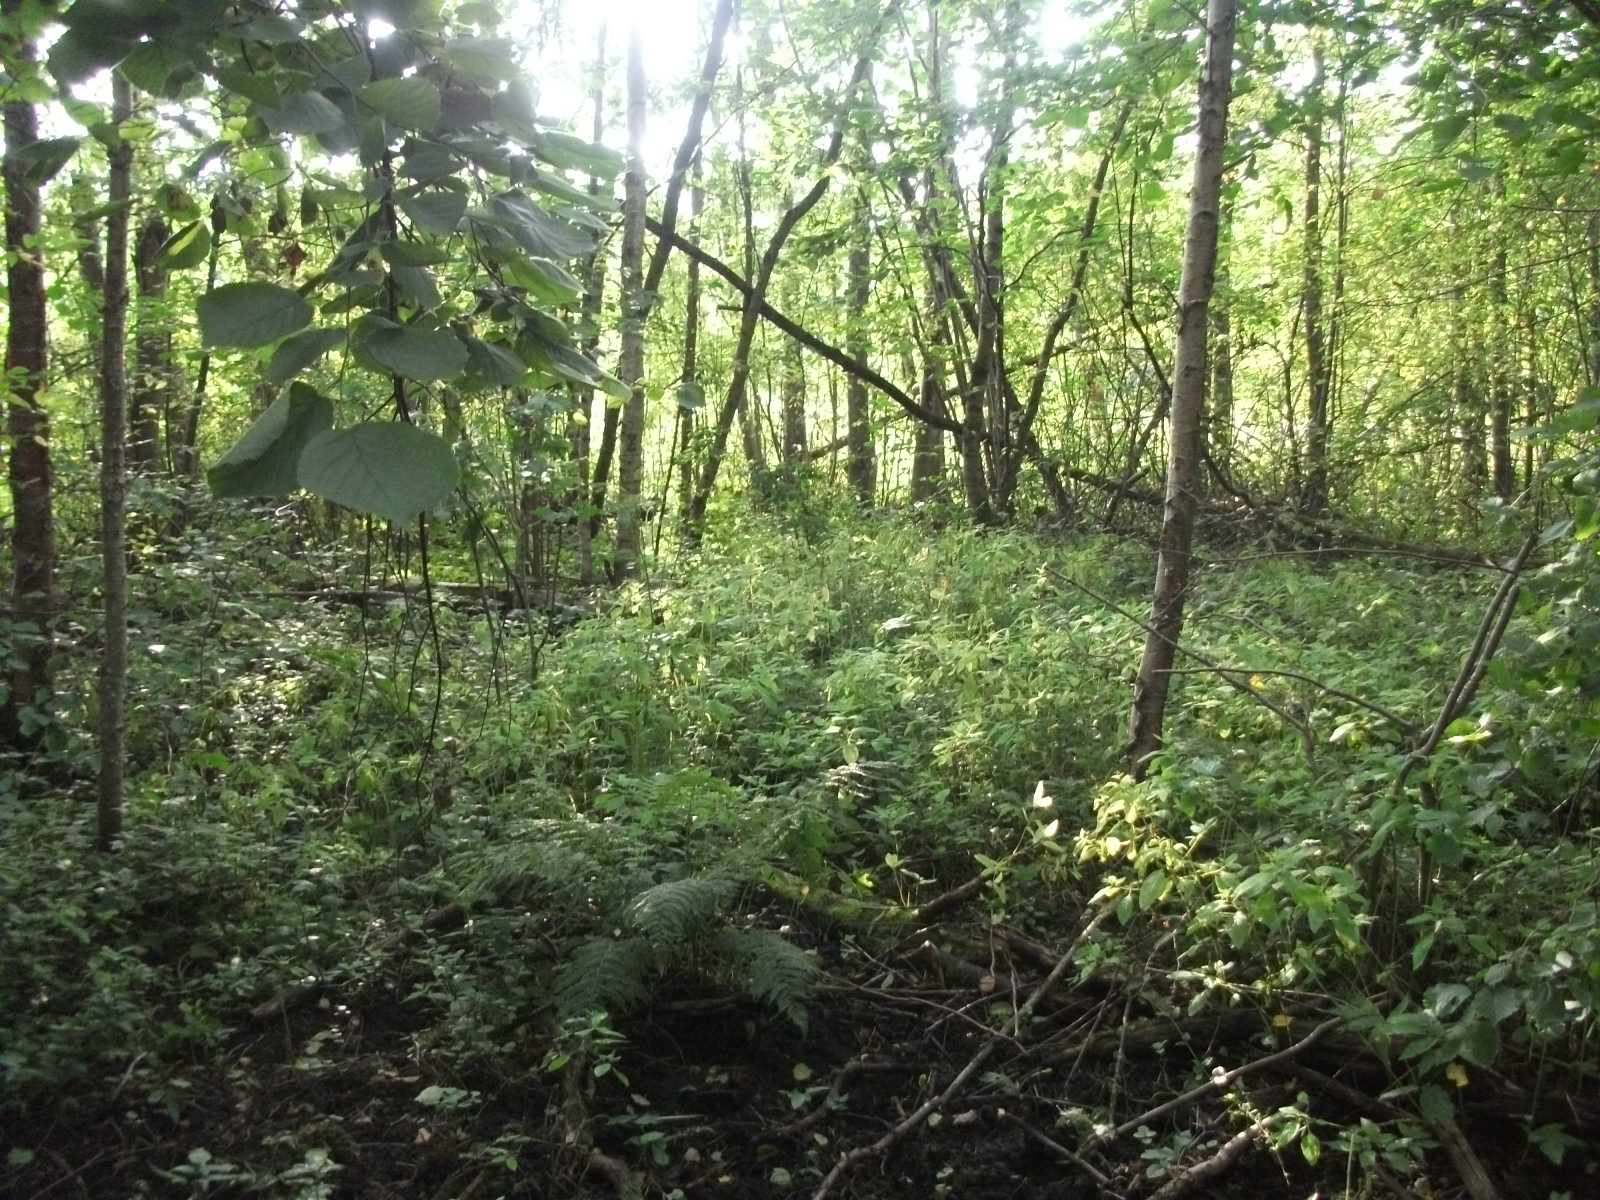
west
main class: Woodland
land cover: Broadleaved woodland
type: non-riverine alder, birch or aspen forest
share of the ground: > 75 %
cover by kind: broadleaved forest trees 75 %, herbaceous plants 10 %, coniferous forest trees 5 %, shrubs 5 %, unconsolidated bare surface 5 %
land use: Forestry
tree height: > 5 m
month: August
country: LV
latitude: 56.9004
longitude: 26.4483
